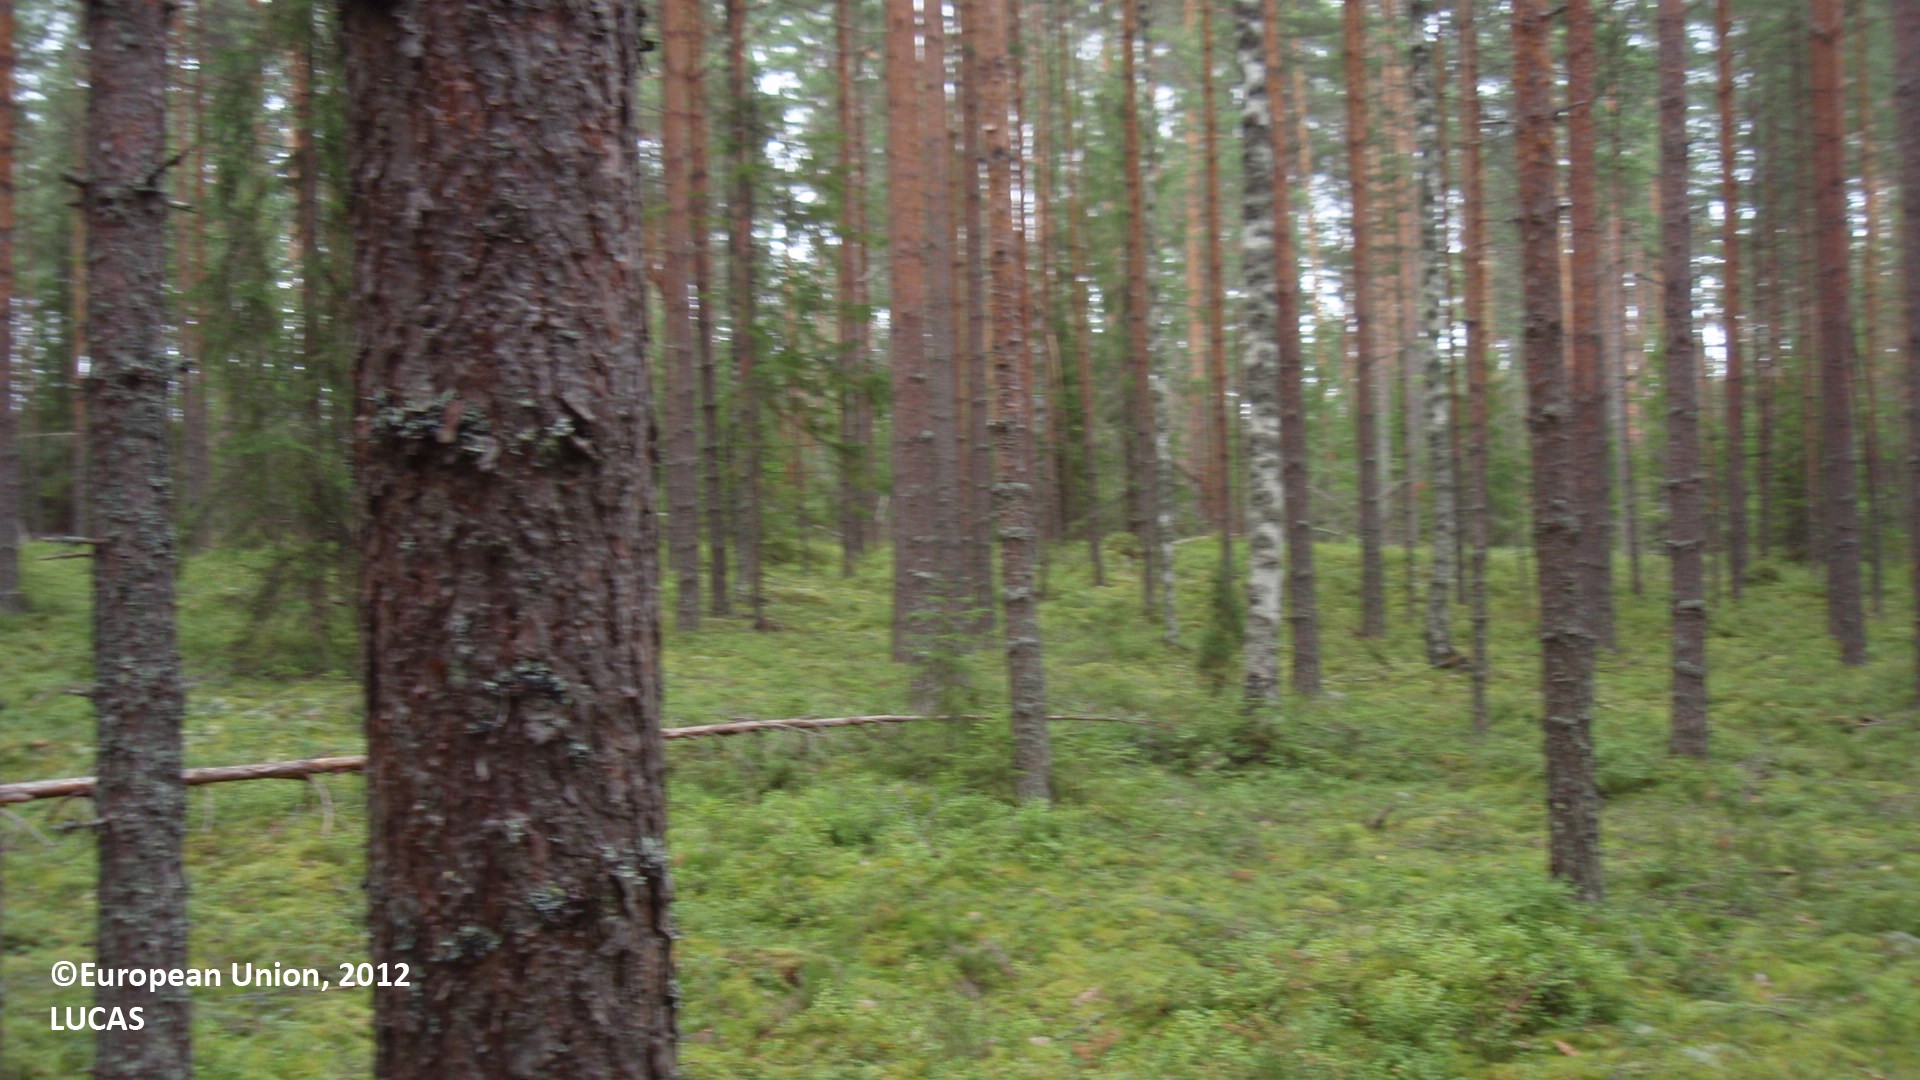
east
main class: Woodland
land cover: Pine dominated mixed woodland
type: boreal forest
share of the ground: 50 - 75 %
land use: Forestry
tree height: > 5 m
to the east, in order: Pine dominated mixed woodland; Shrubland with sparse tree cover; Paved roads, cycling and walking lanes; Pine dominated mixed woodland; Shrubland with sparse tree cover; Ditches and canals; Paved roads, cycling and walking lanes; Pine dominated mixed woodland
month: August
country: FI
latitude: 60.9331
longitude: 27.4334
